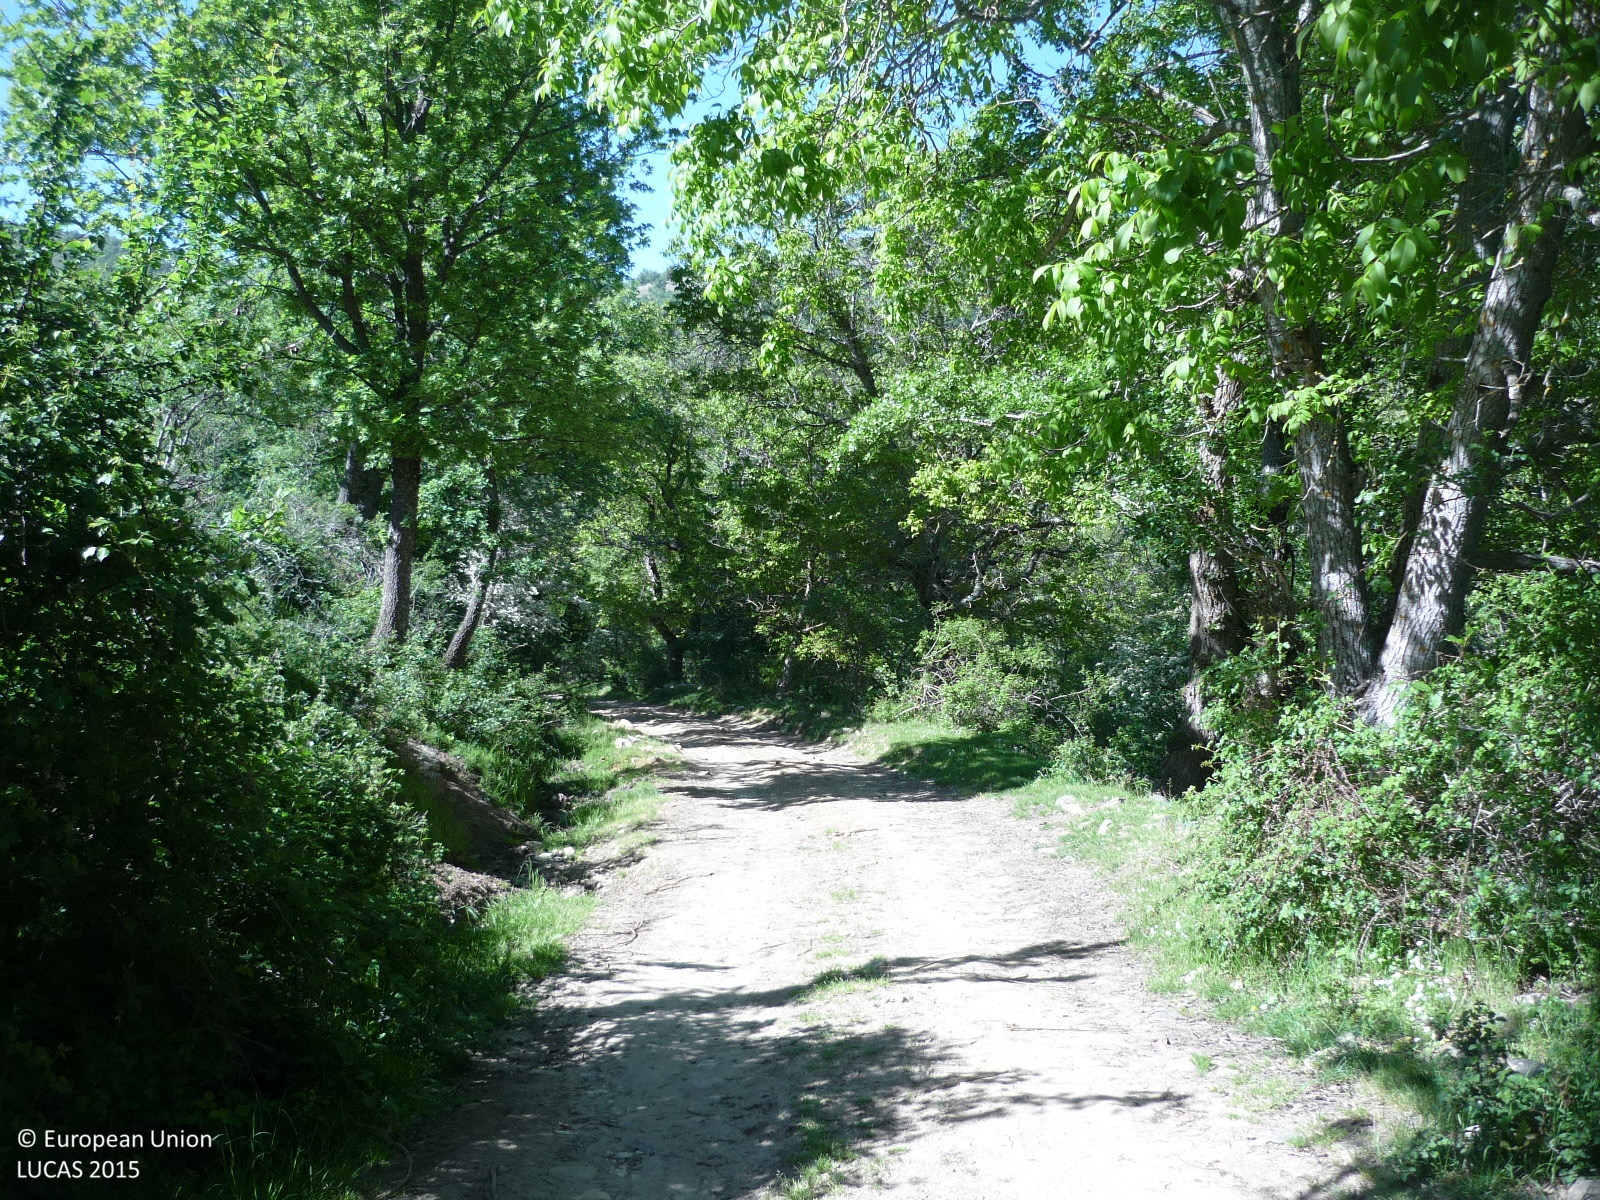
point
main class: Grassland
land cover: Grassland without tree/shrub cover
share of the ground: > 75 %
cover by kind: herbaceous plants 95 %, shrubs 5 %
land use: Agriculture (excluding fallow land and kitchen gardens)
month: May
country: ES
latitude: 41.1555
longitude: -3.4011
